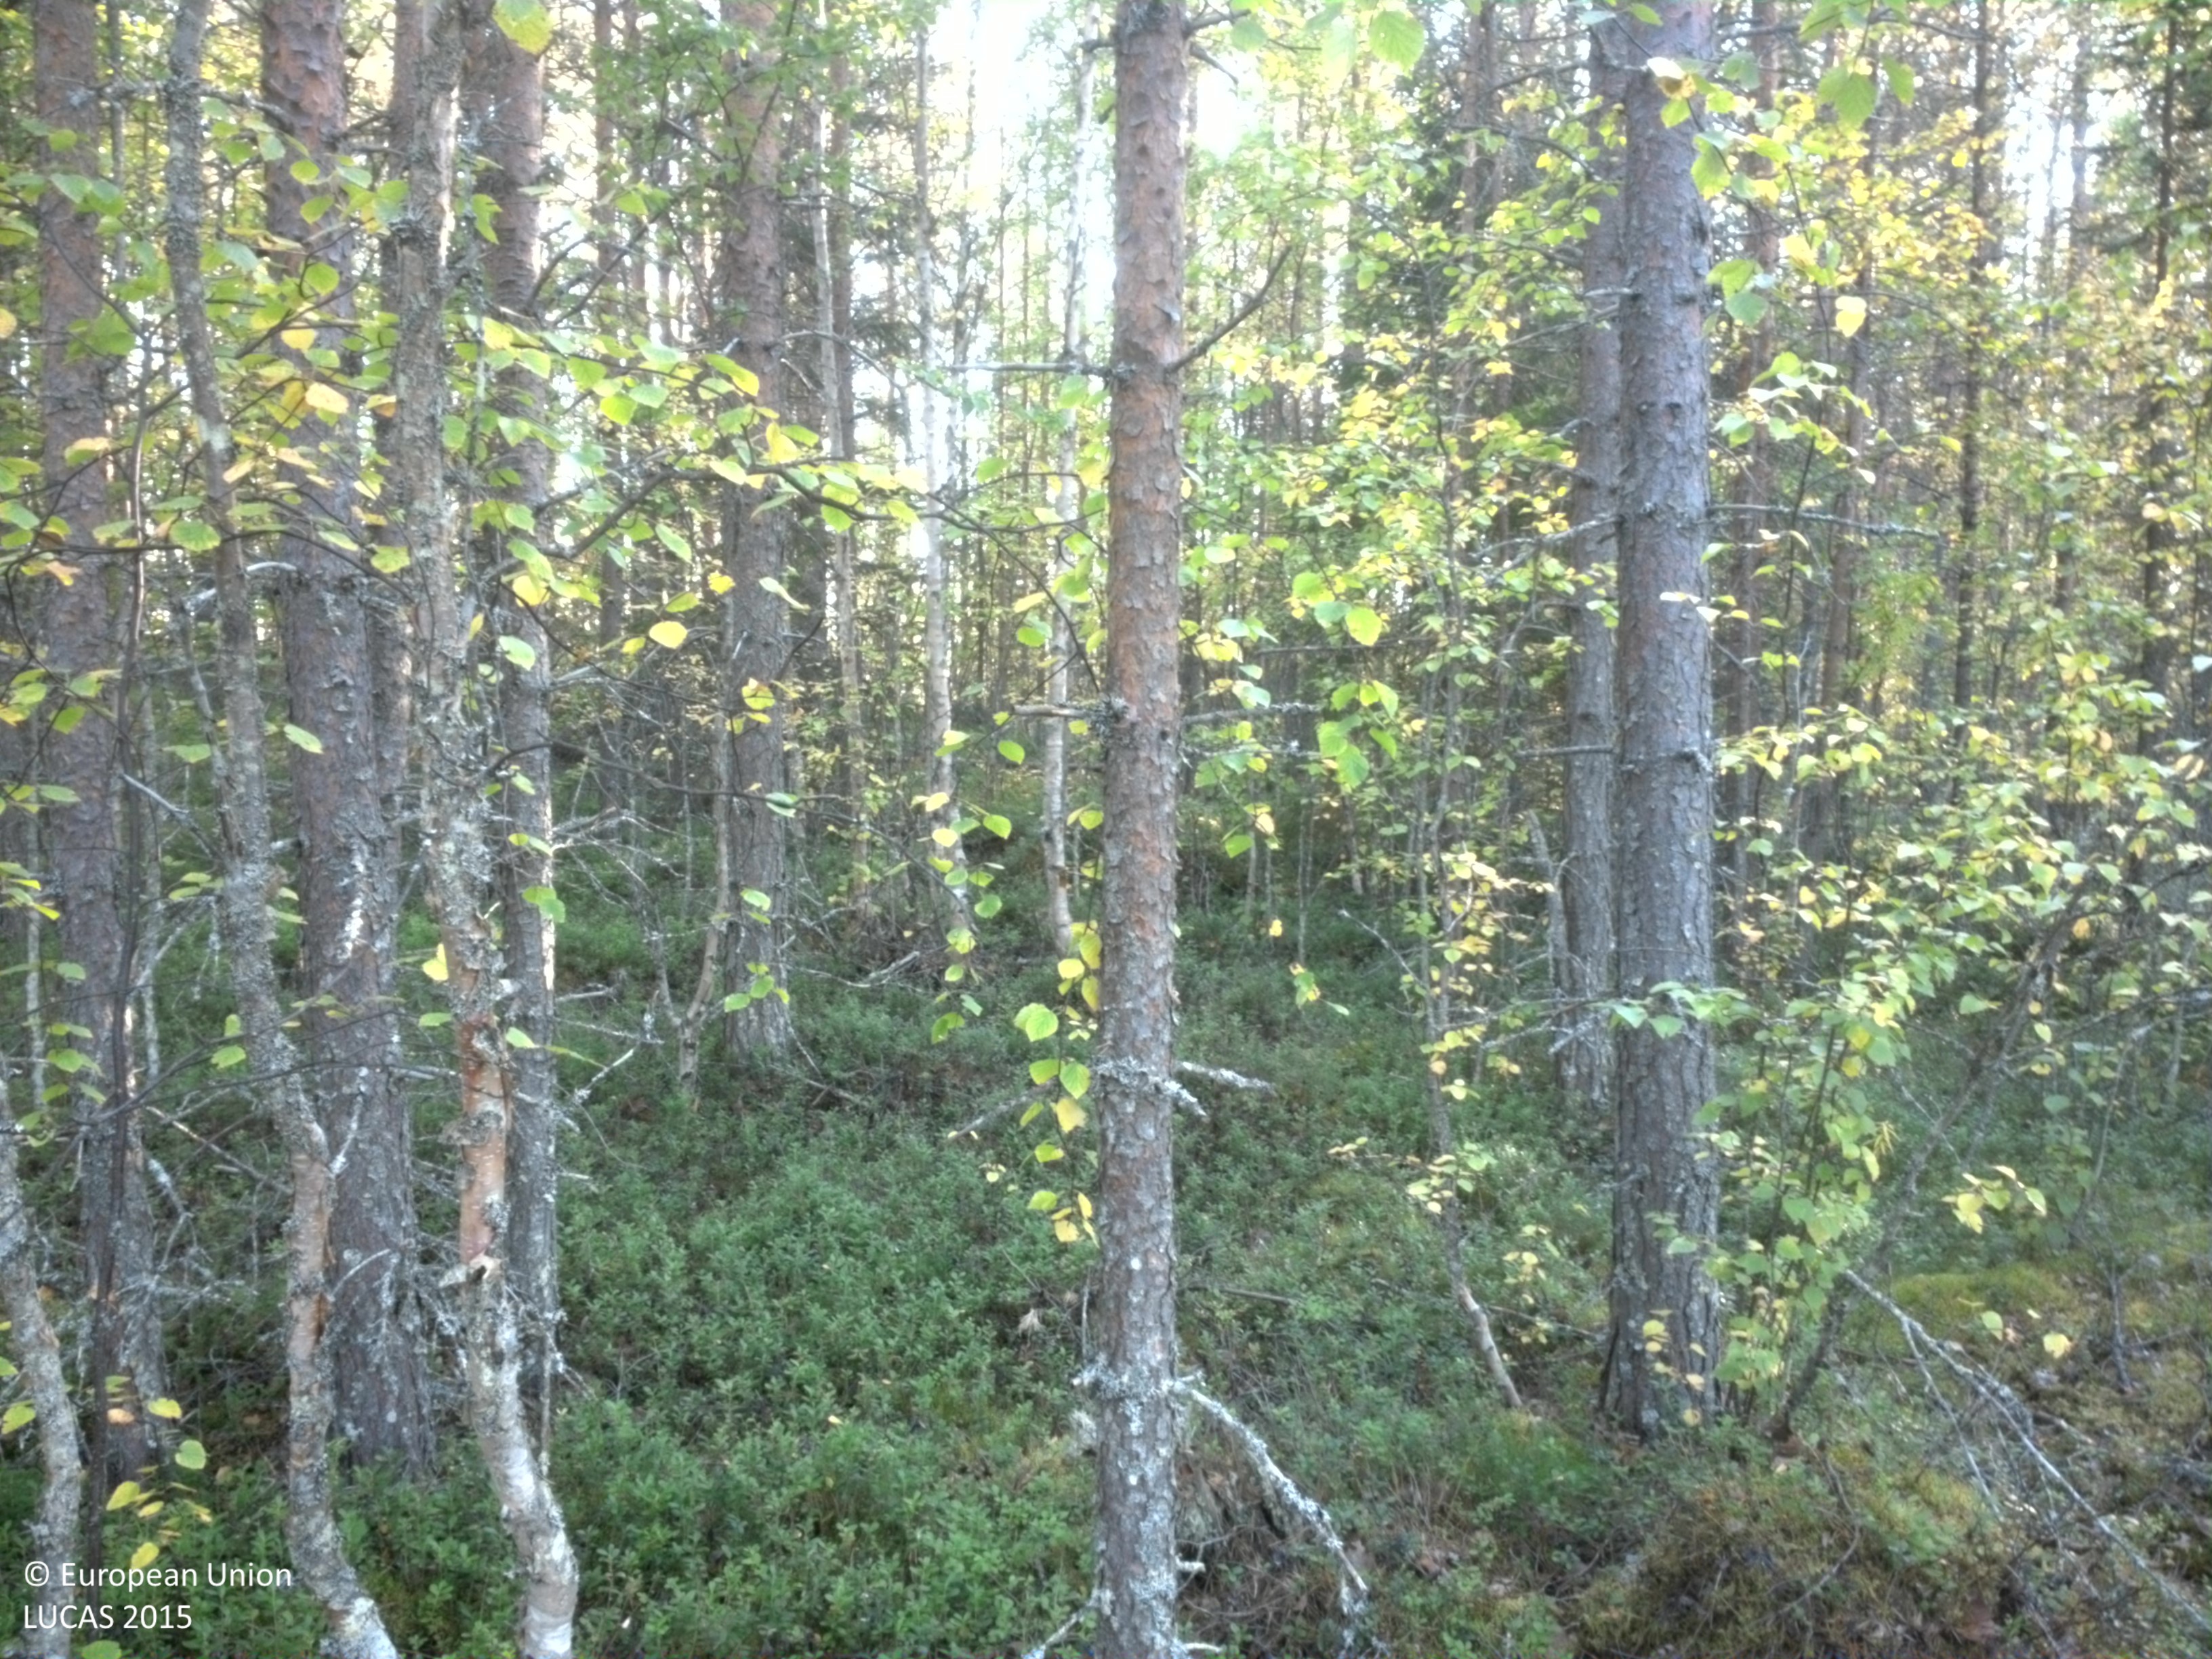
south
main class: Woodland
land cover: Pine dominated mixed woodland
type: boreal forest
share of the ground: 50 - 75 %
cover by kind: coniferous forest trees 45 %, shrubs 30 %, broadleaved forest trees 15 %, lichens and mosses 10 %
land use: Forestry
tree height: > 5 m
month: September
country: SE
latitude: 64.3719
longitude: 19.7337
